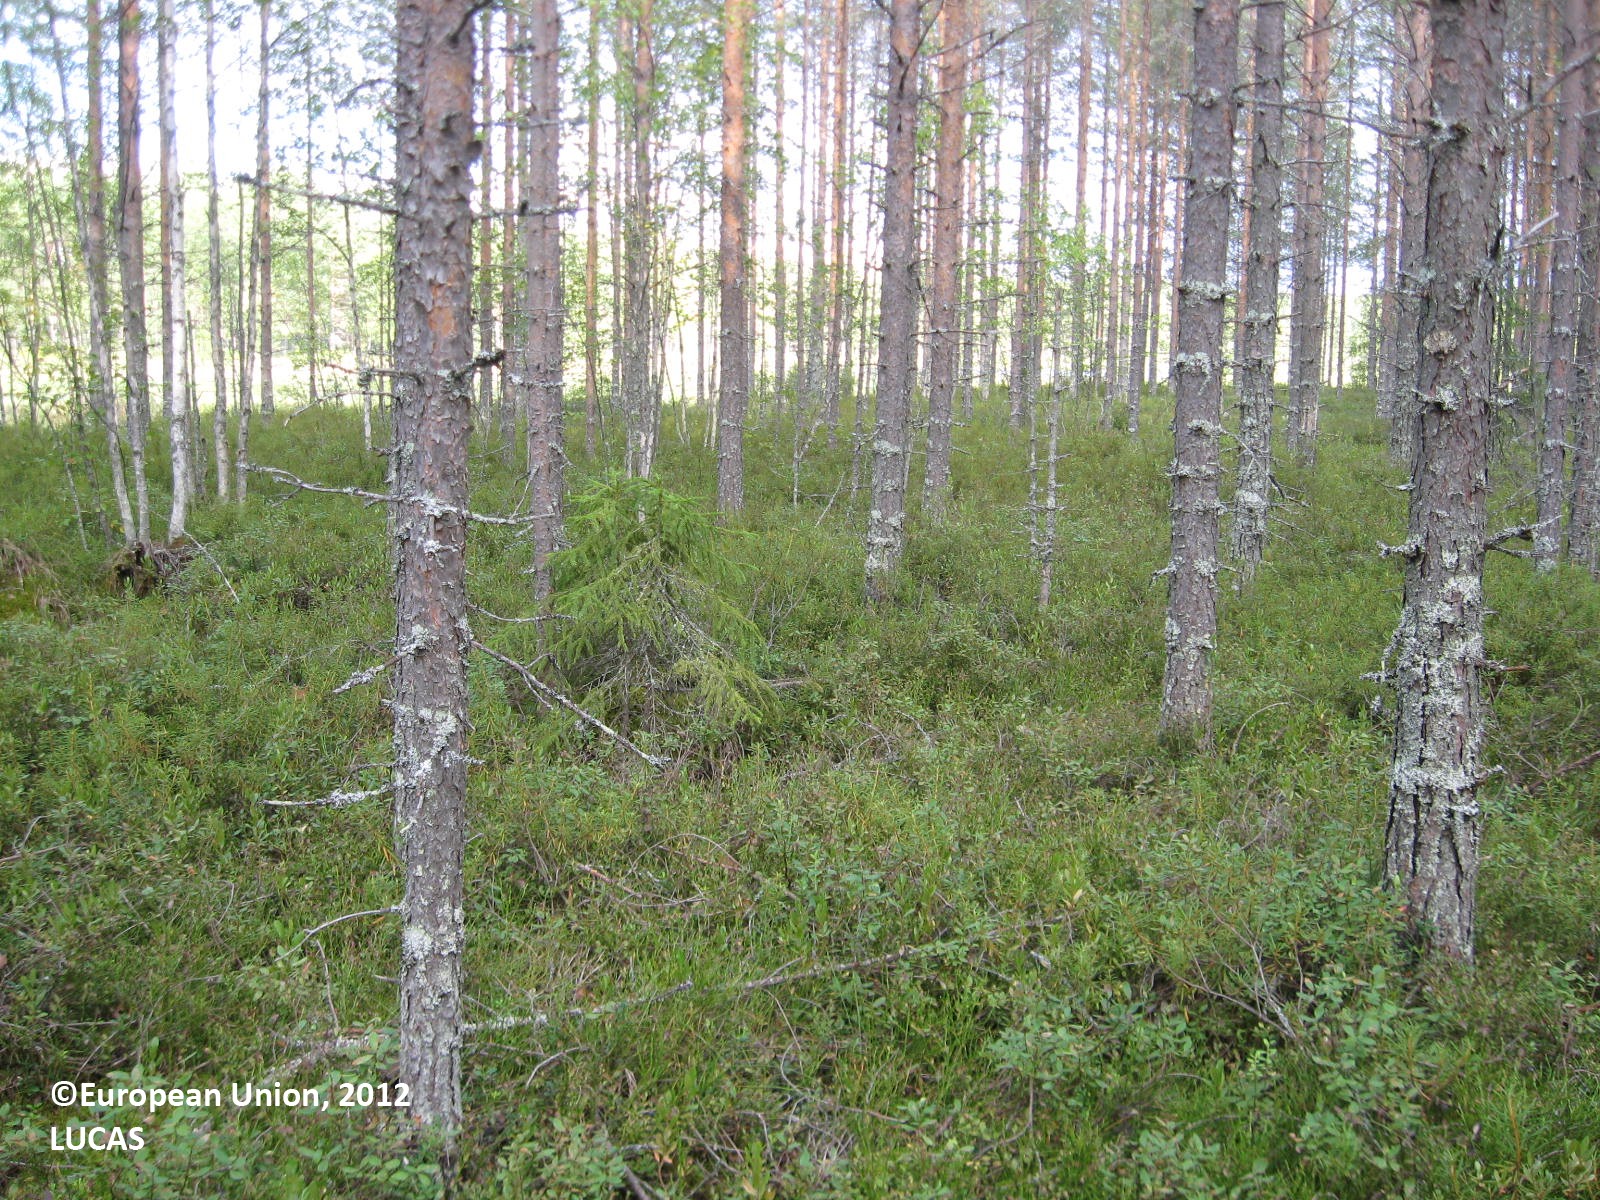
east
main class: Woodland
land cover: Pine dominated coniferous woodland
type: boreal forest
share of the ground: > 75 %
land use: Forestry
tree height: > 5 m
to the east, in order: Pine dominated coniferous woodland; Inland water bodies
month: August
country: FI
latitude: 63.4198
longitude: 30.1468
